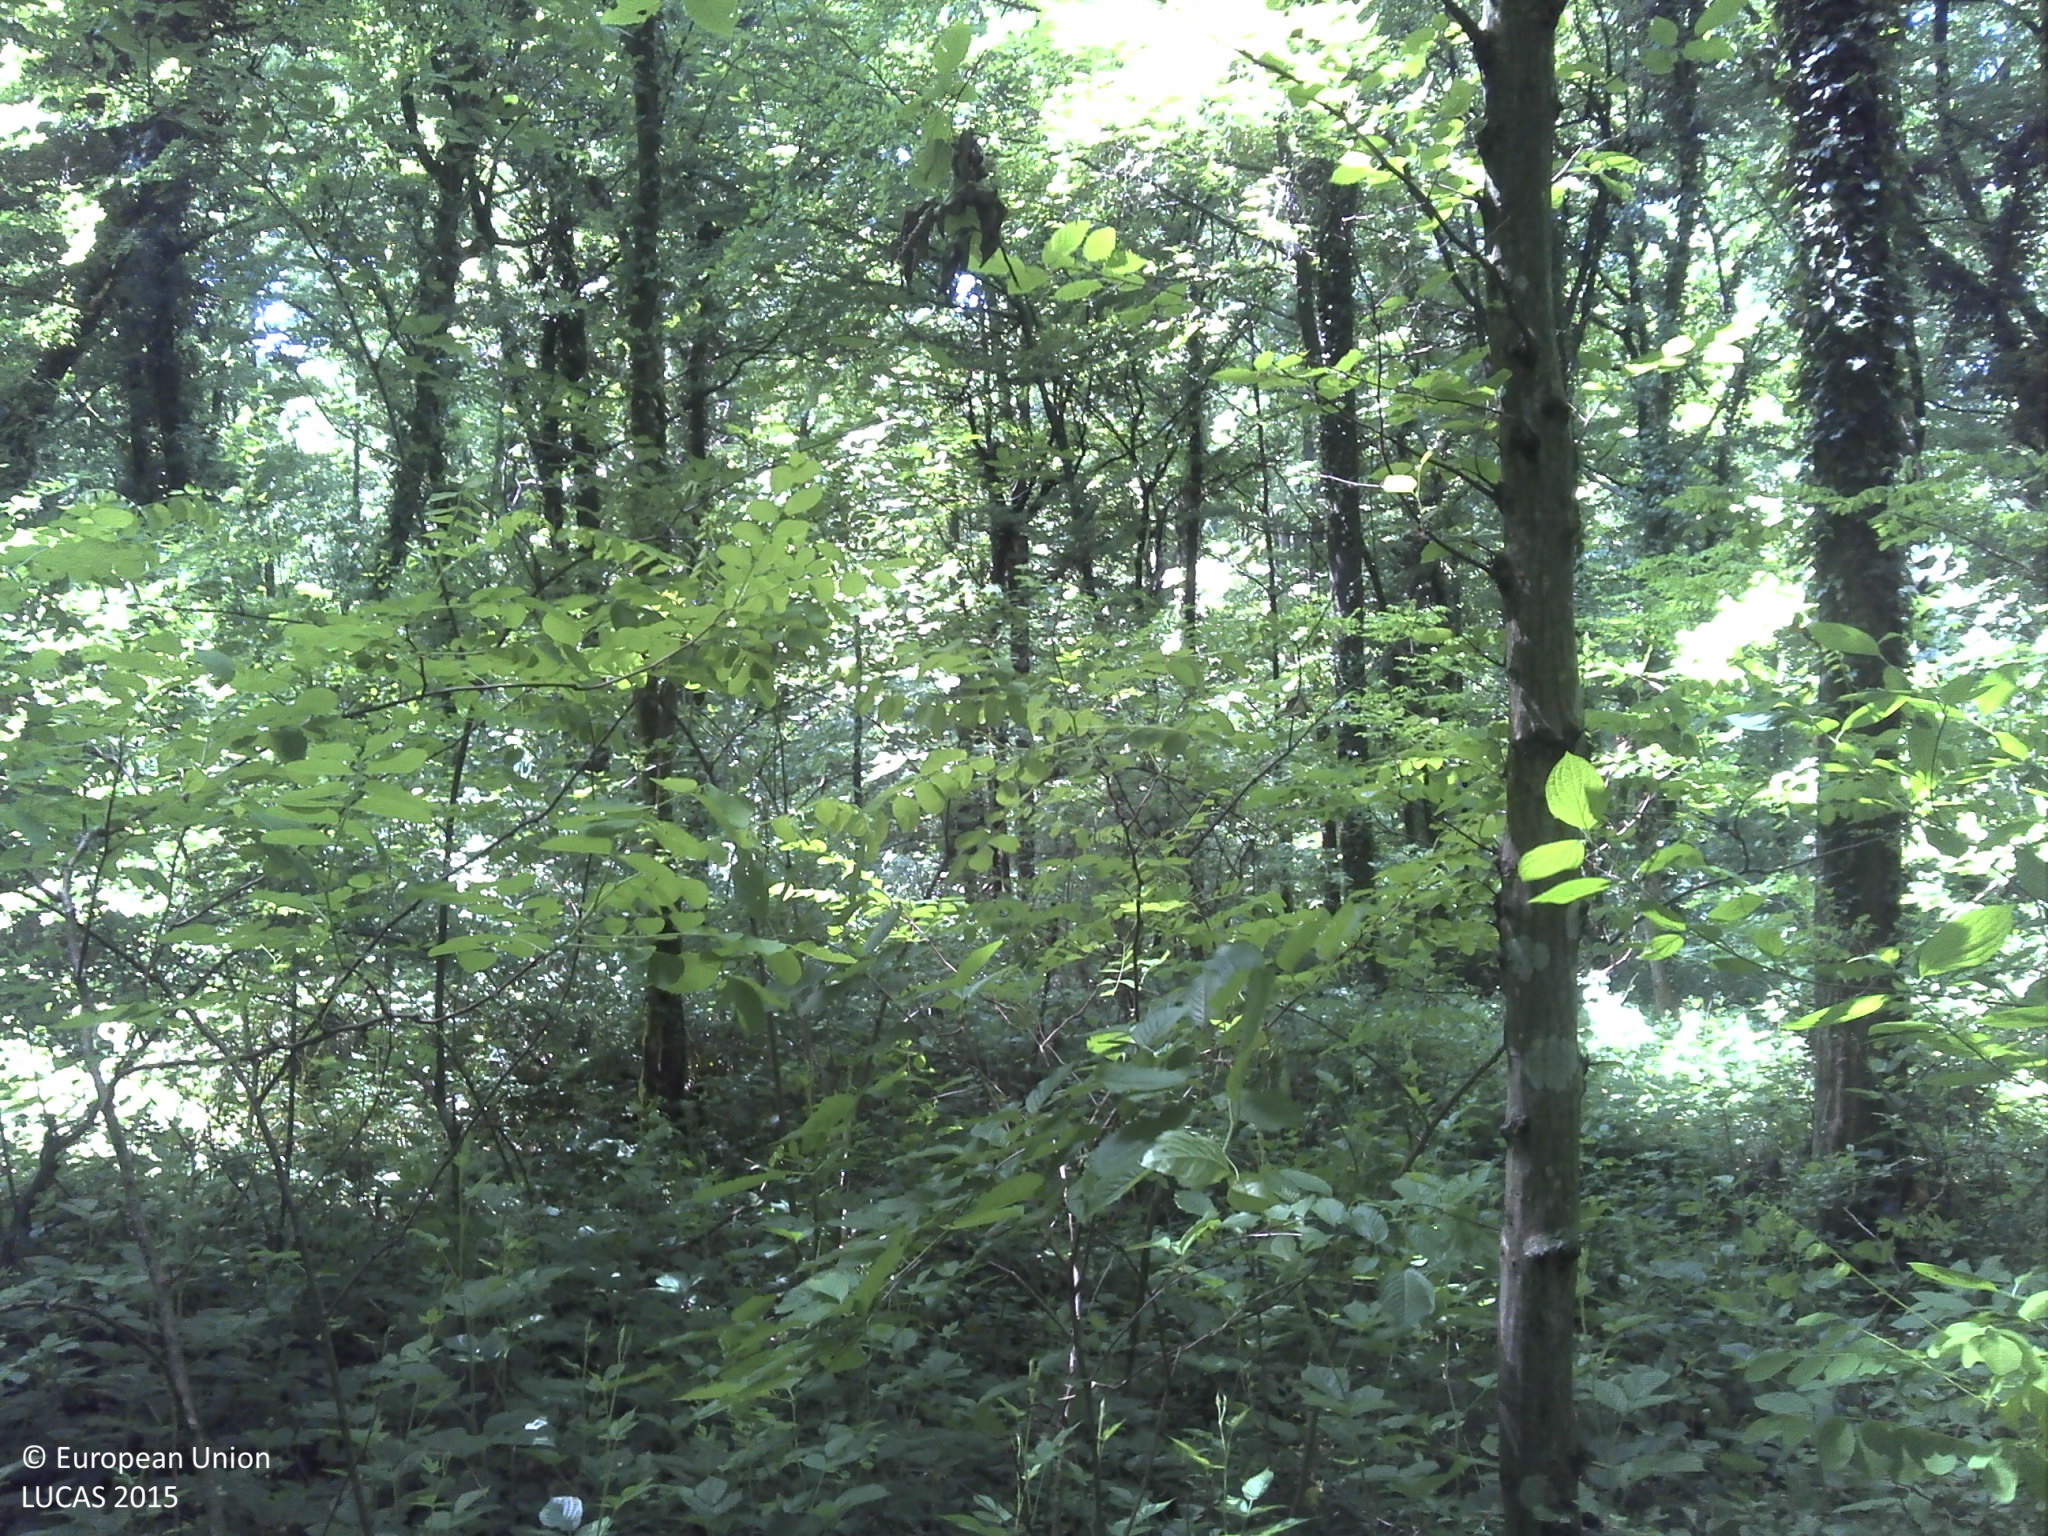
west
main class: Woodland
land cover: Broadleaved woodland
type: acidophilous oak and oak-birch forest
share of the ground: > 75 %
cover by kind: broadleaved forest trees 80 %, lichens and mosses 20 %
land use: Forestry
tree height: > 5 m
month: May
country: HR
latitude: 45.2716
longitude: 18.2508
